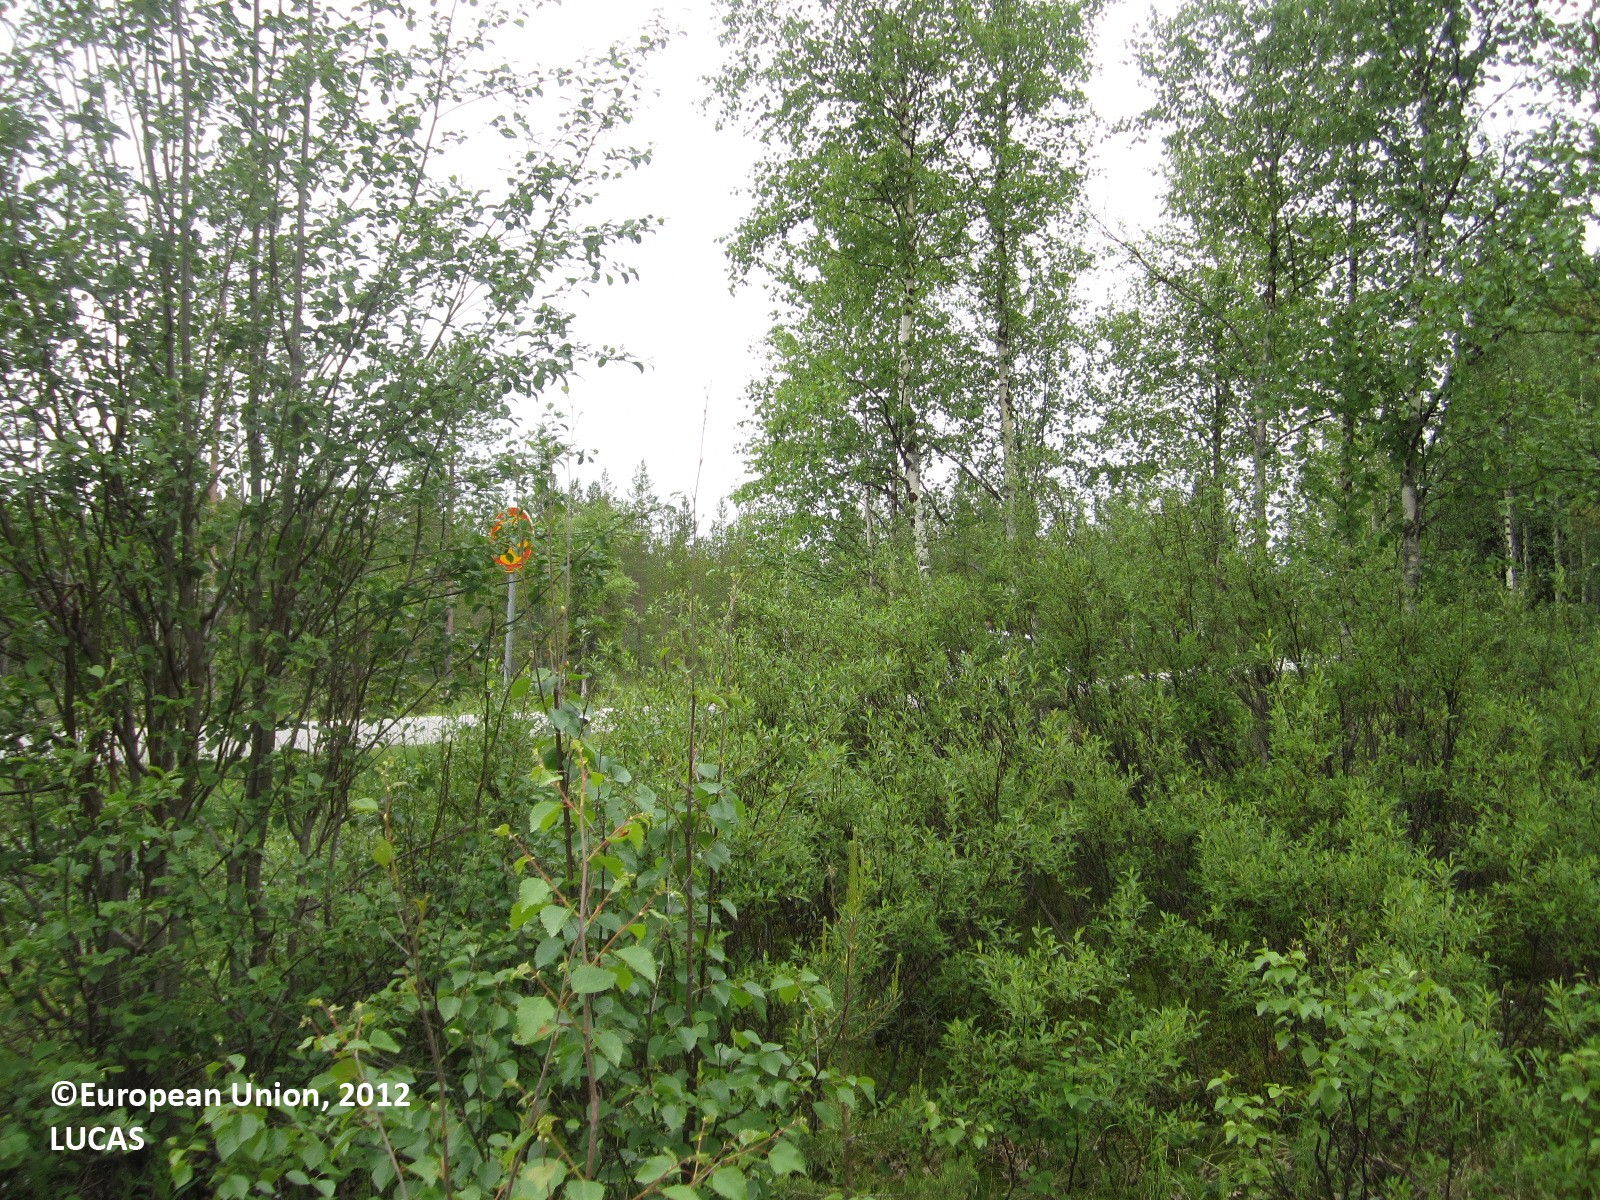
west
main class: Woodland
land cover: Broadleaved woodland
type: boreal forest
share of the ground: 50 - 75 %
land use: Forestry
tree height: > 5 m
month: June
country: FI
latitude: 64.7212
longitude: 29.6733
